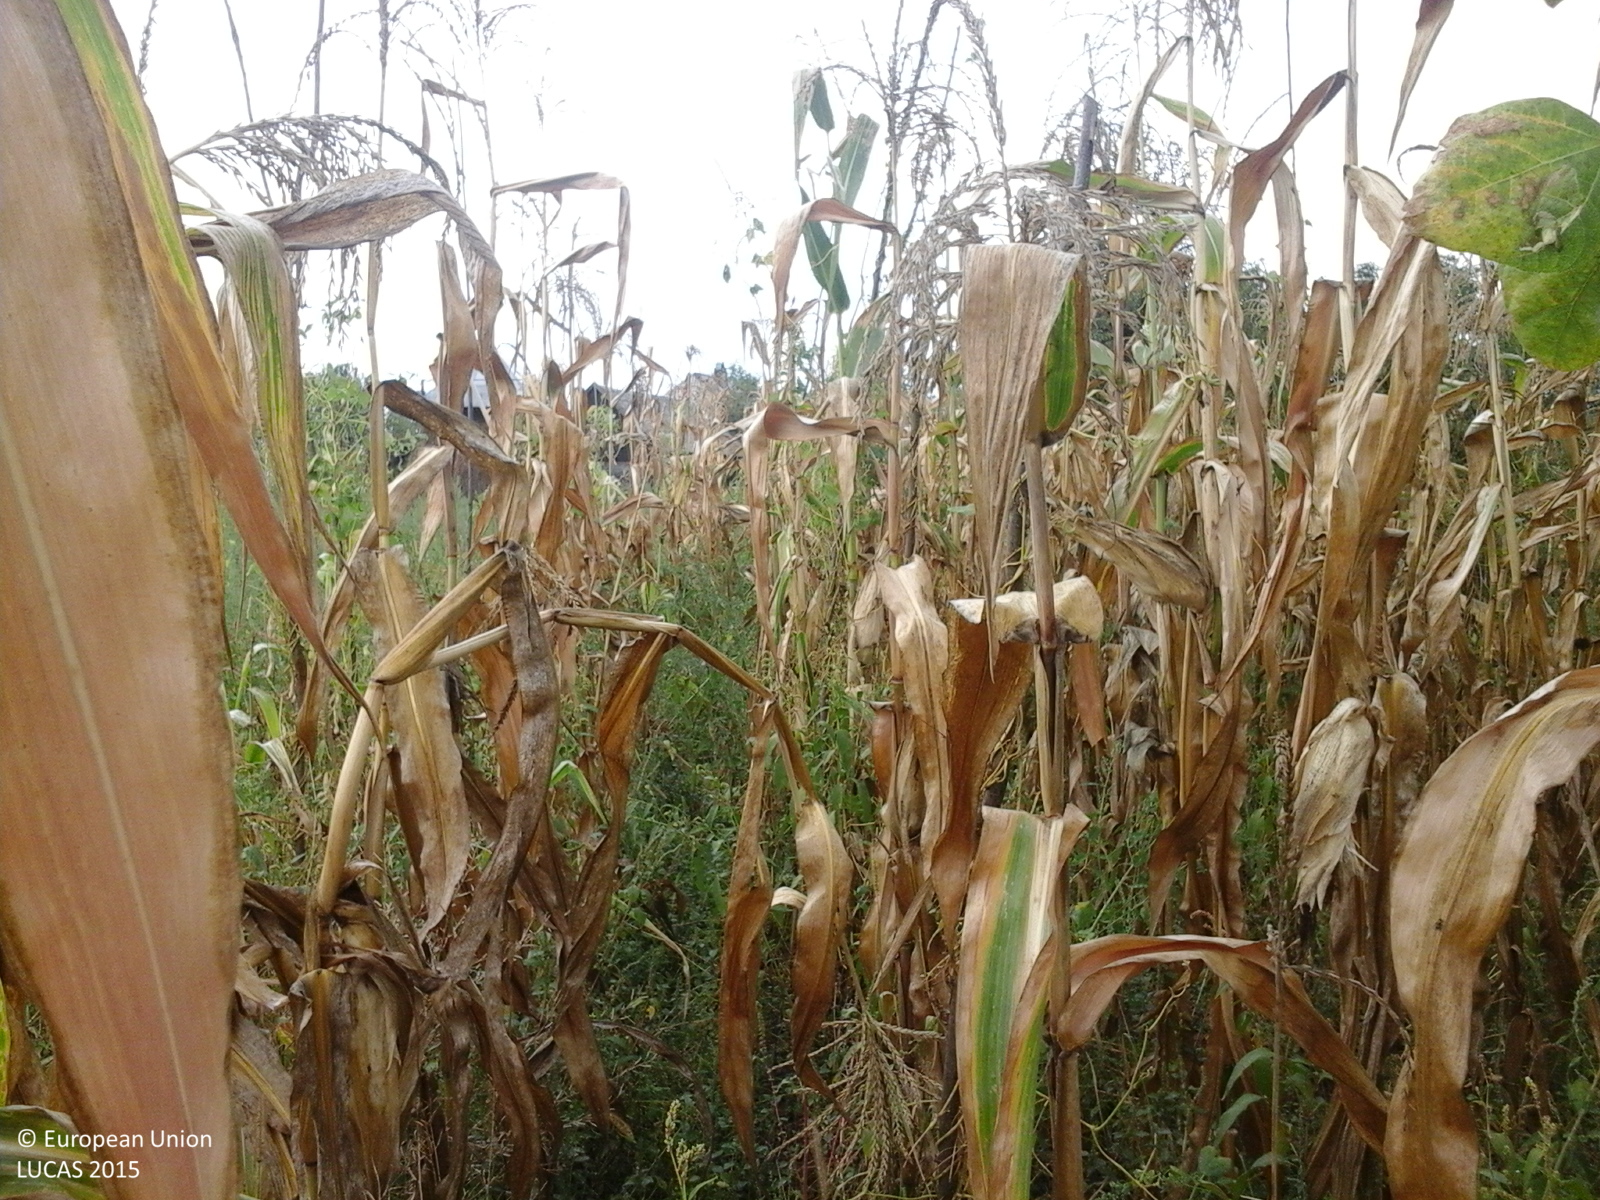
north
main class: Cropland
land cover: Maize
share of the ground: 50 - 75 %
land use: Agriculture (excluding fallow land and kitchen gardens)
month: September
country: RO
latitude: 47.8822
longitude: 23.9243
